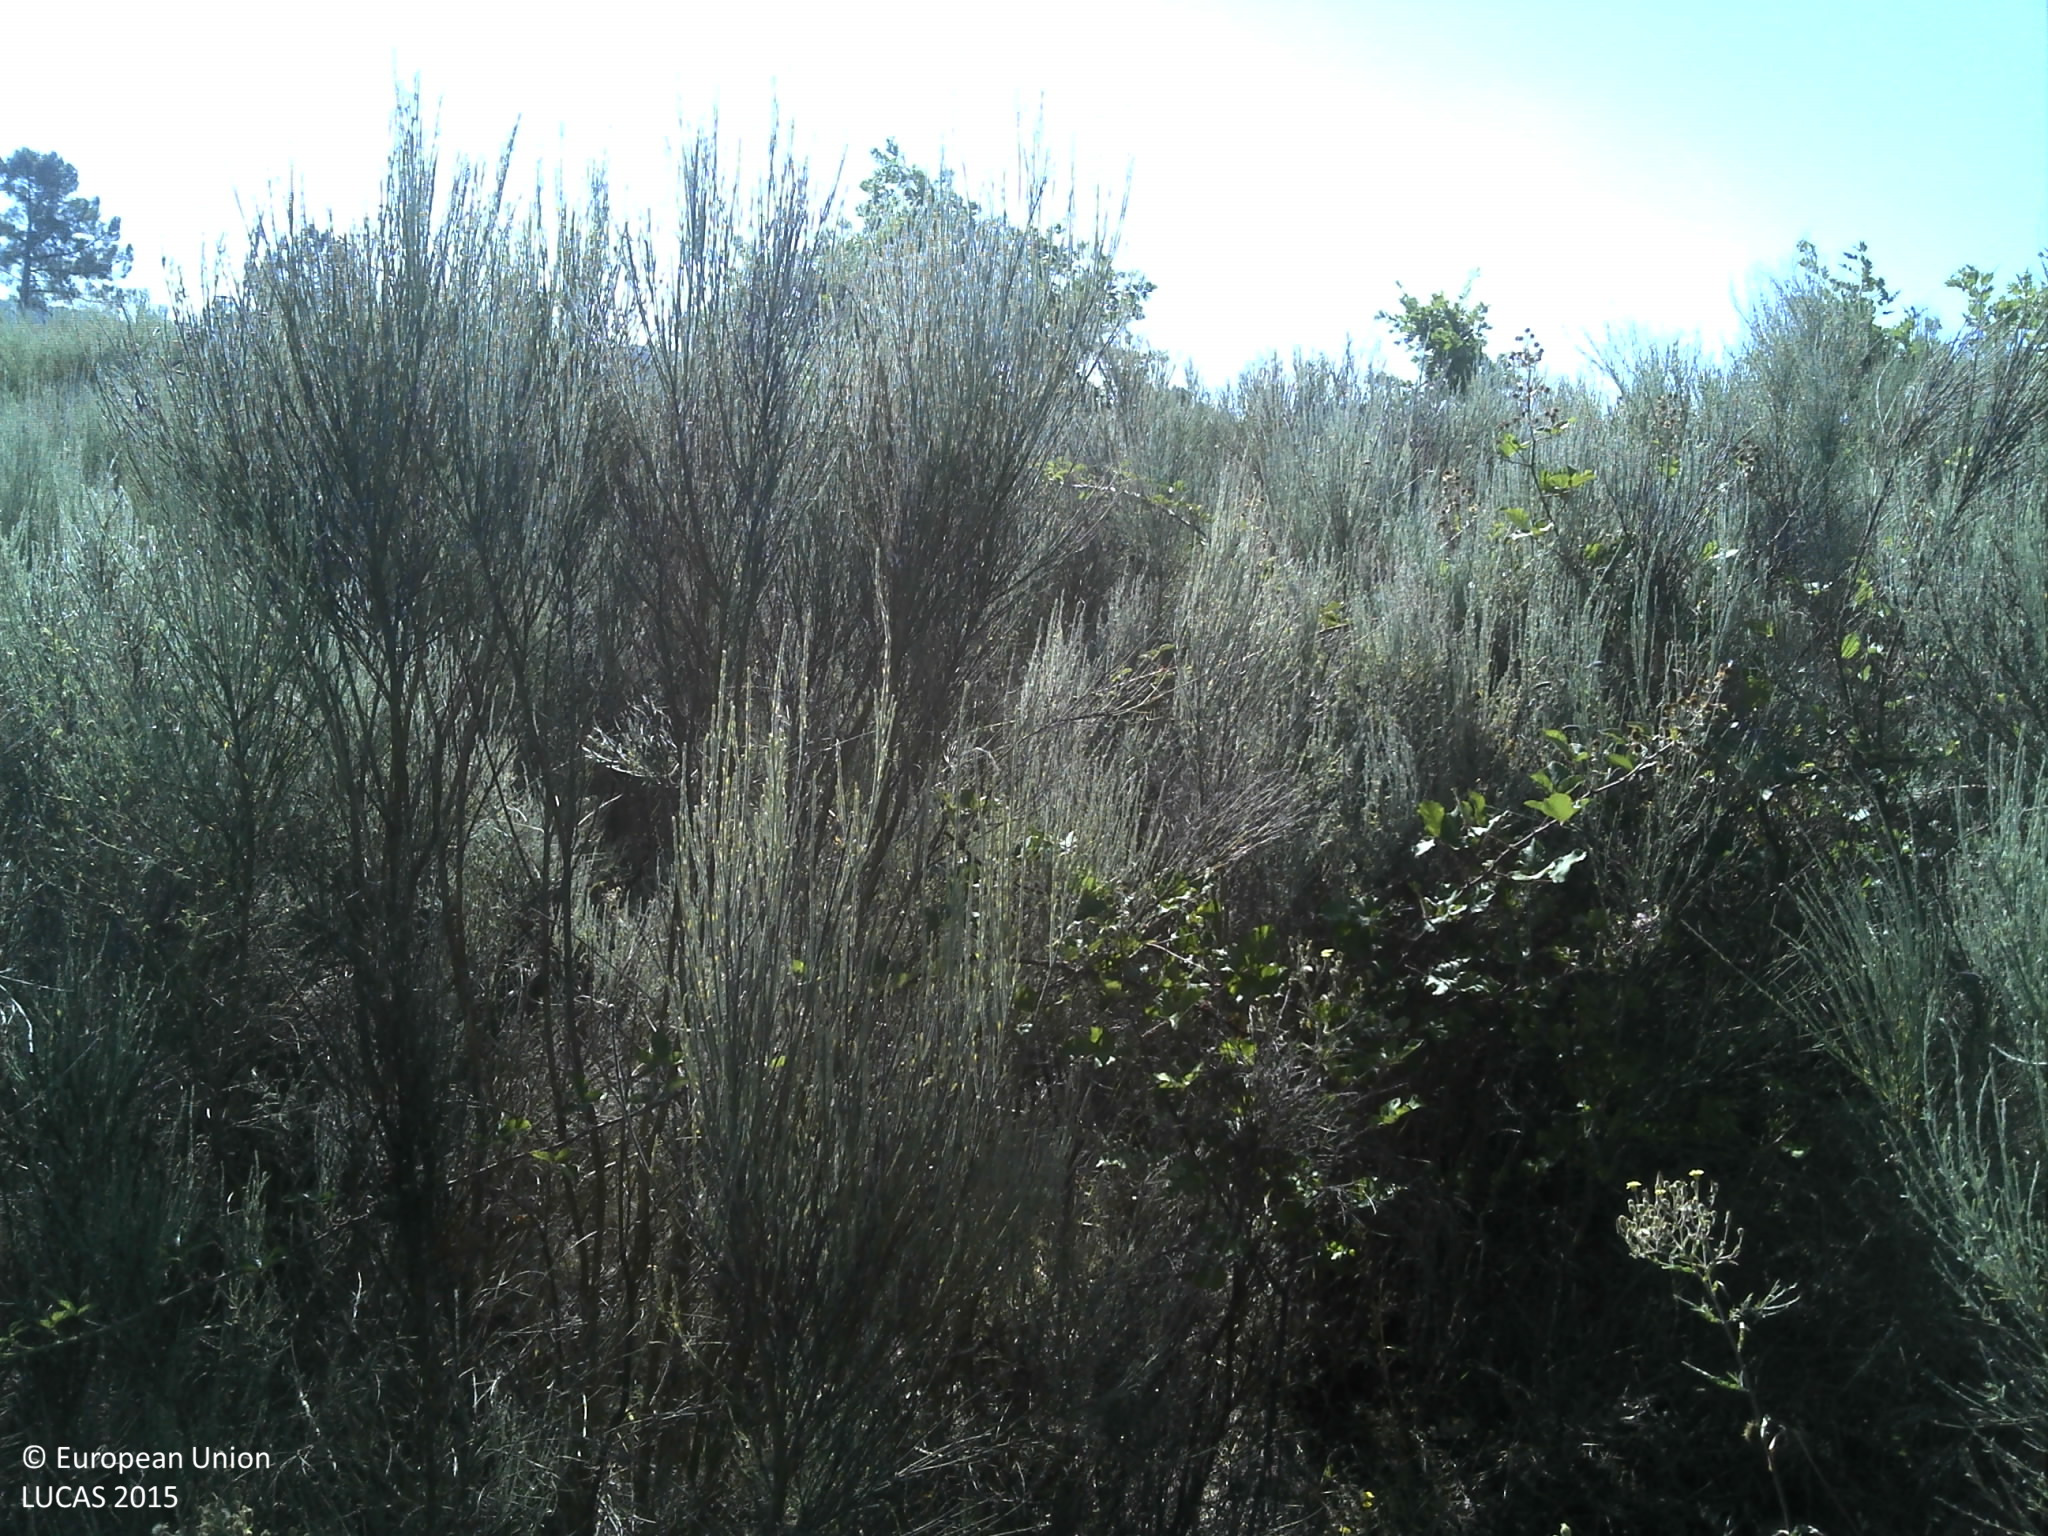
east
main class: Woodland
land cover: Broadleaved woodland
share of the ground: 10 - 25 %
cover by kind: shrubs 90 %, broadleaved forest trees 10 %
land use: Abandoned areas
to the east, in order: Broadleaved woodland; Vineyards; Shrubland with sparse tree cover; Rock outcrops; Grassland without tree/shrub cover; Shrubland with sparse tree cover; Dry stone walls; Tracks; Dry stone walls; Single bushes/trees; Other bare soil
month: June
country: PT
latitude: 40.8123
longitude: -7.2401
